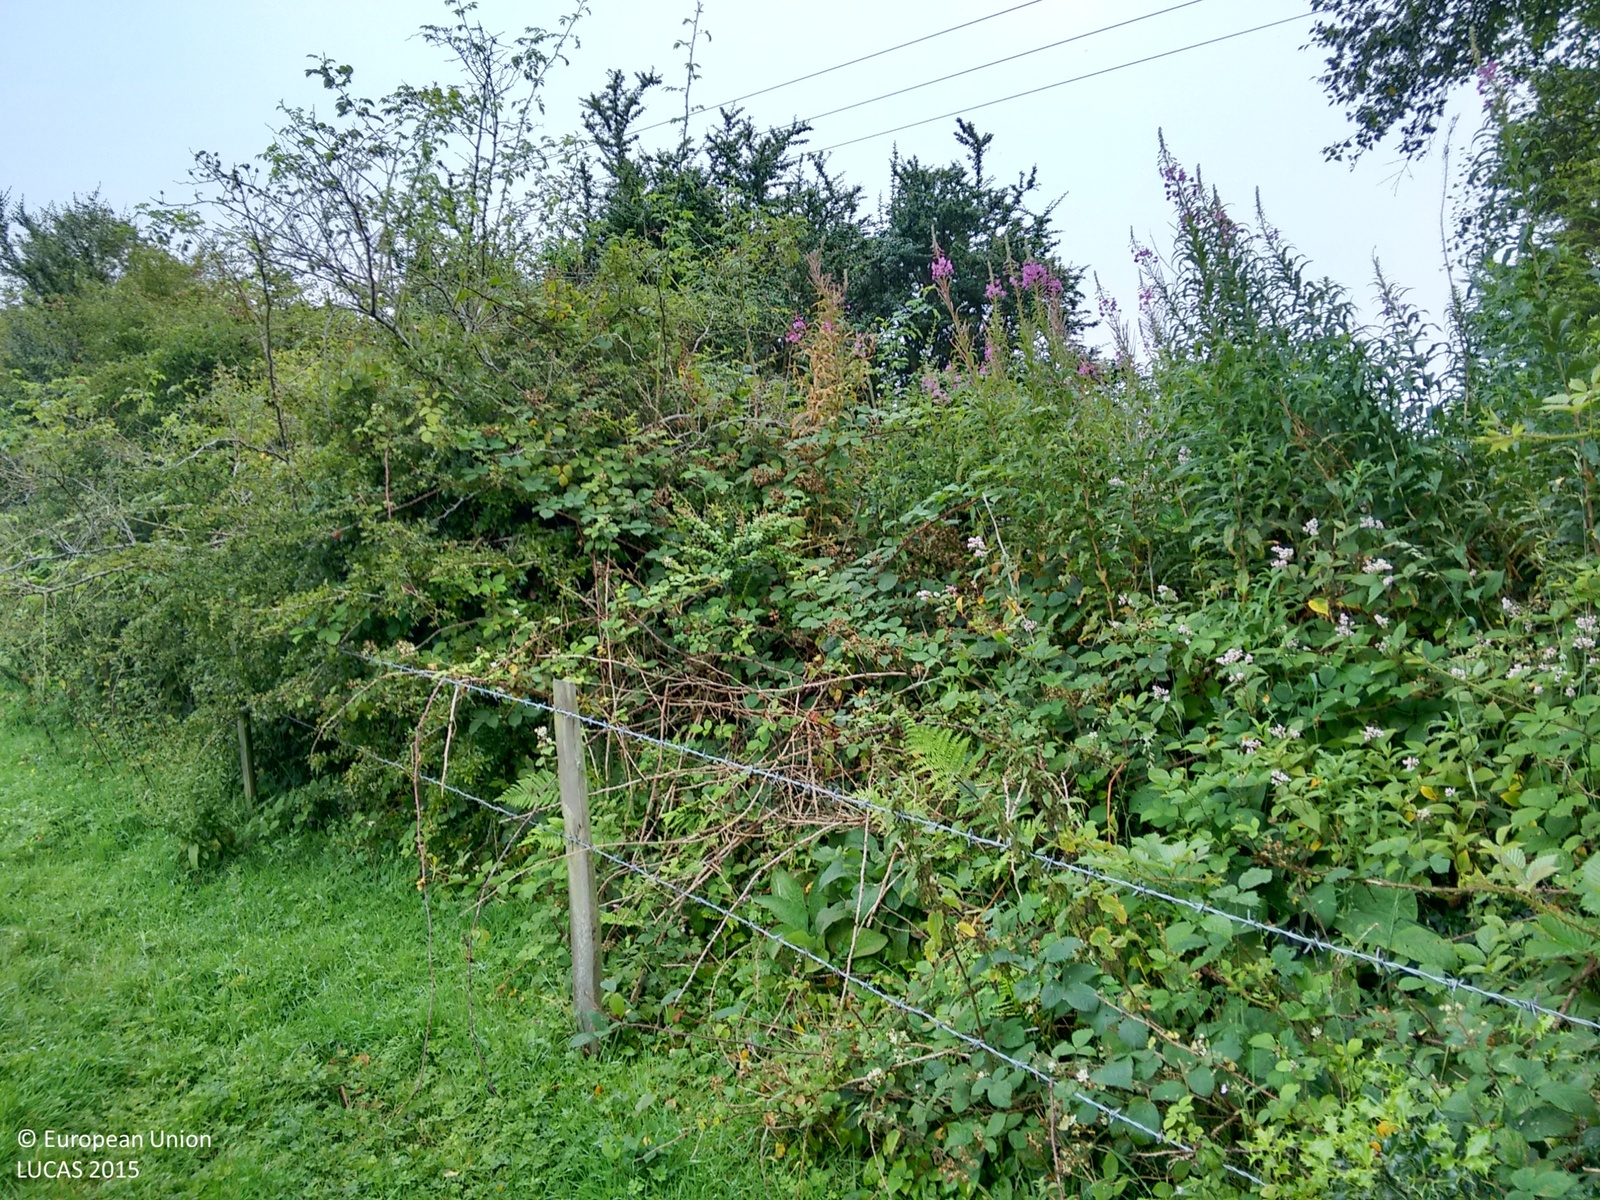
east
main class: Grassland
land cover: Grassland without tree/shrub cover
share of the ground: > 75 %
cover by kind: herbaceous plants 100 %
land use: Agriculture (excluding fallow land and kitchen gardens)
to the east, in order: Managed hedges; Grassland without tree/shrub cover; Tracks; Electric lines; Single bushes/trees; Grass margins; Fences; Grassland without tree/shrub cover; Spruce dominated coniferous woodland; Grassland without tree/shrub cover; Fences; Spruce dominated coniferous woodland; Abandoned hedges
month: August
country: GB
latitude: 51.7557
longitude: -4.6390
